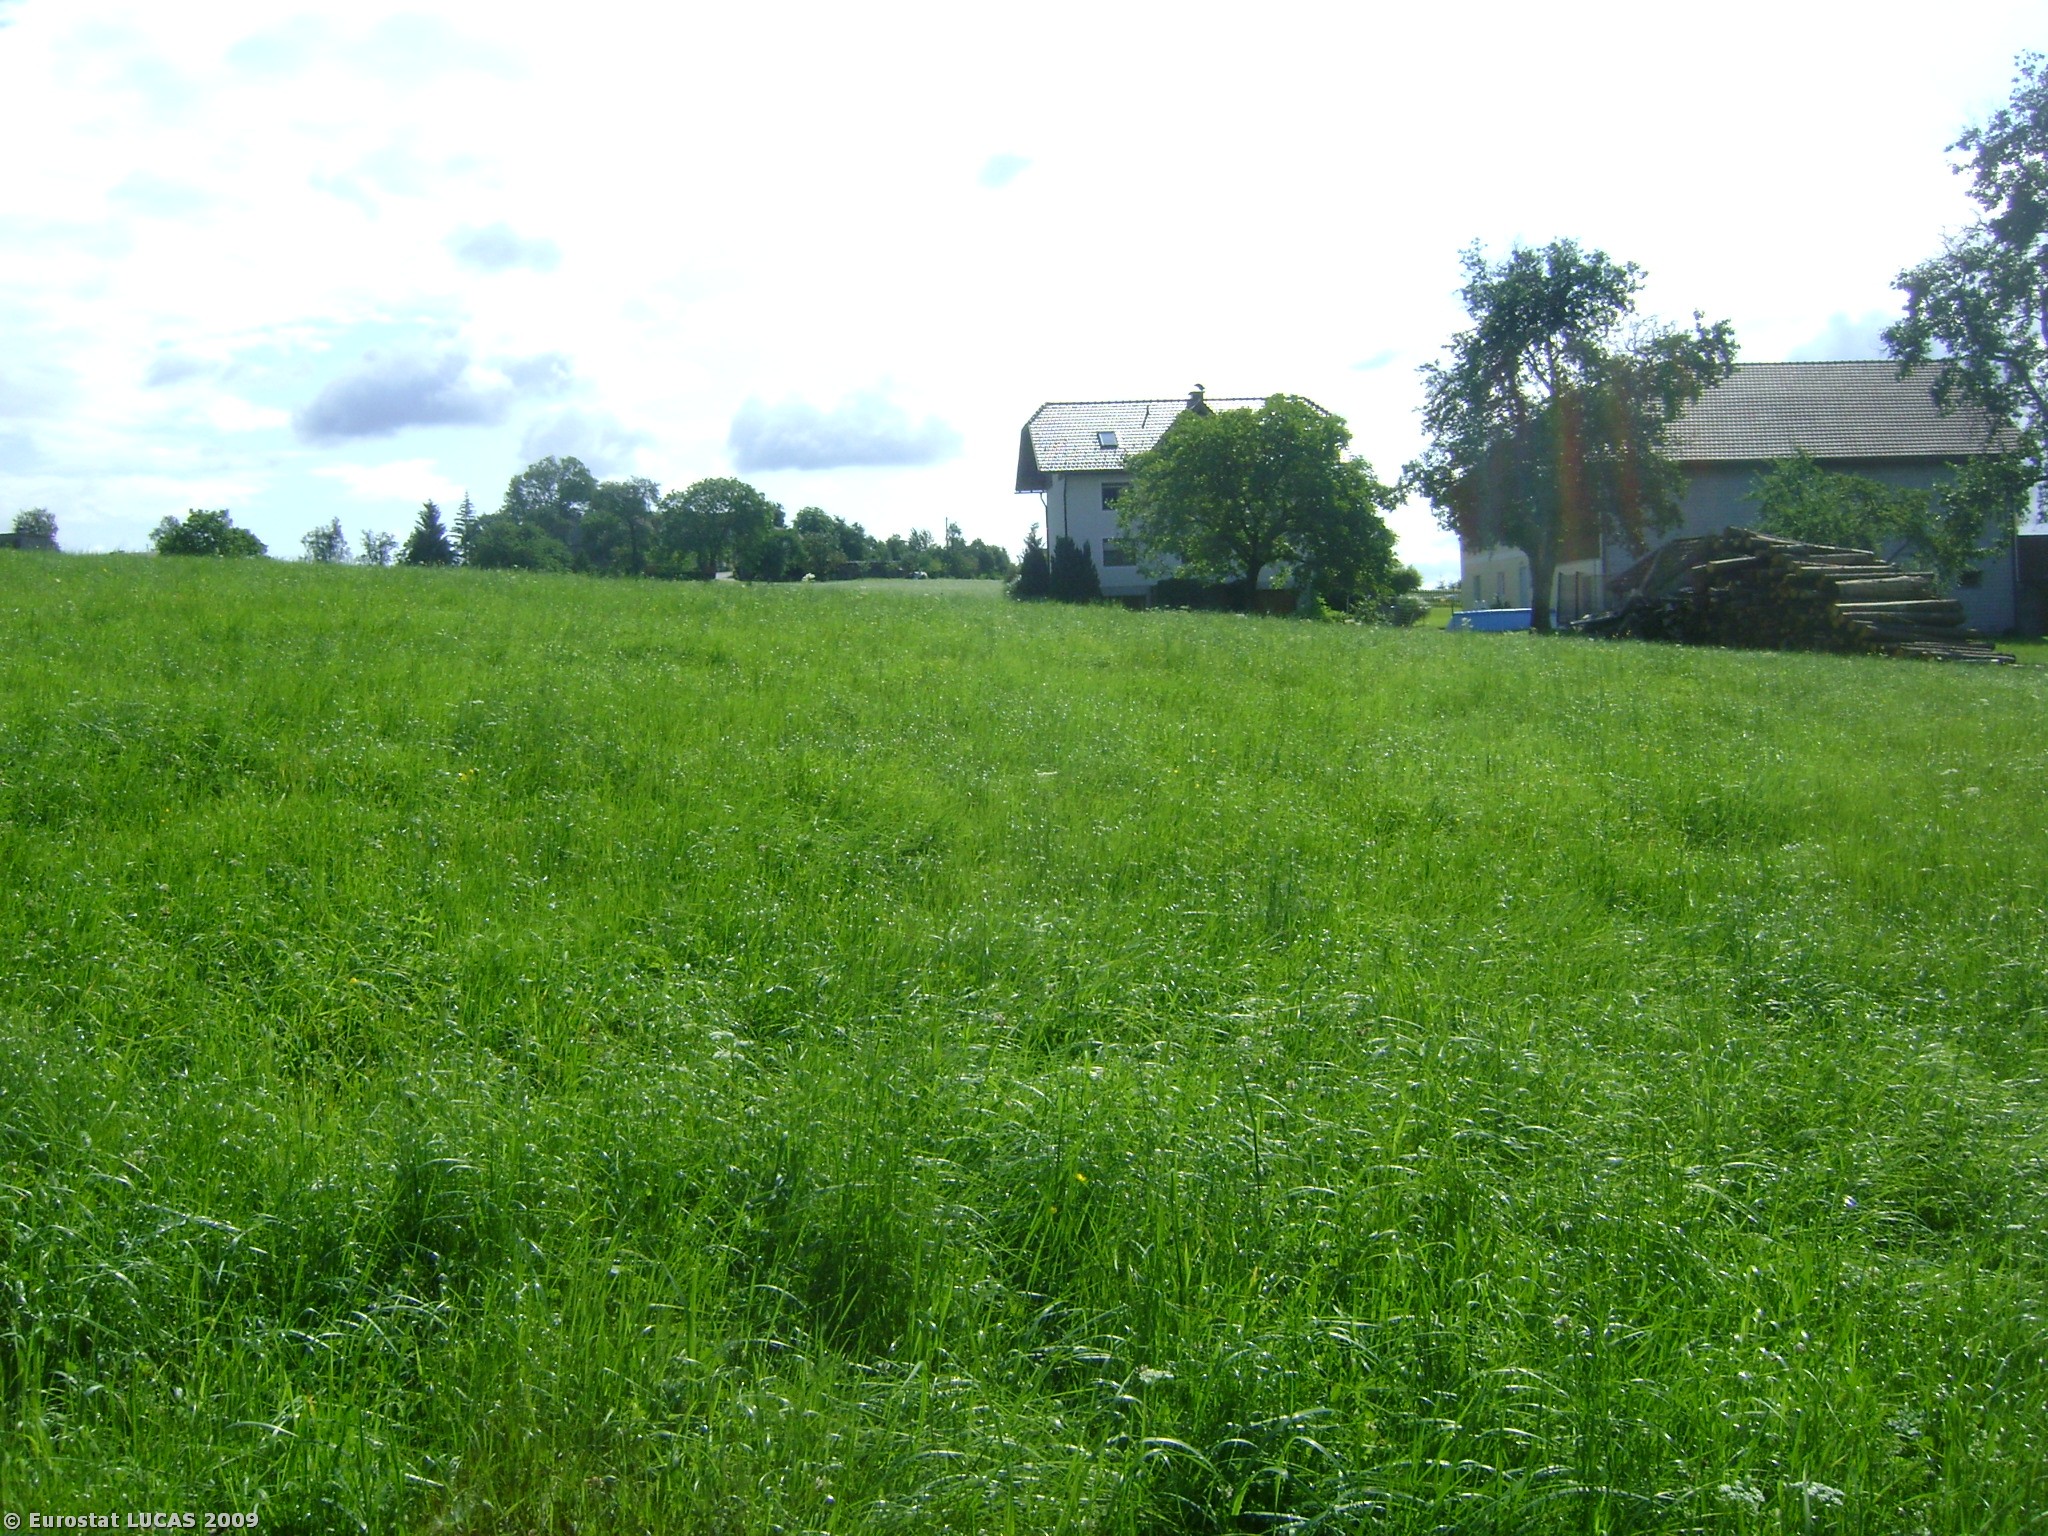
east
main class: Grassland
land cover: Grassland without tree/shrub cover
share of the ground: > 75 %
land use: Agriculture (excluding fallow land and kitchen gardens)
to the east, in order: Grassland without tree/shrub cover; Artificial constructions in urban areas; Paved roads, cycling and walking lanes; Grassland without tree/shrub cover
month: July
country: AT
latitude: 48.0411
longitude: 13.5268
